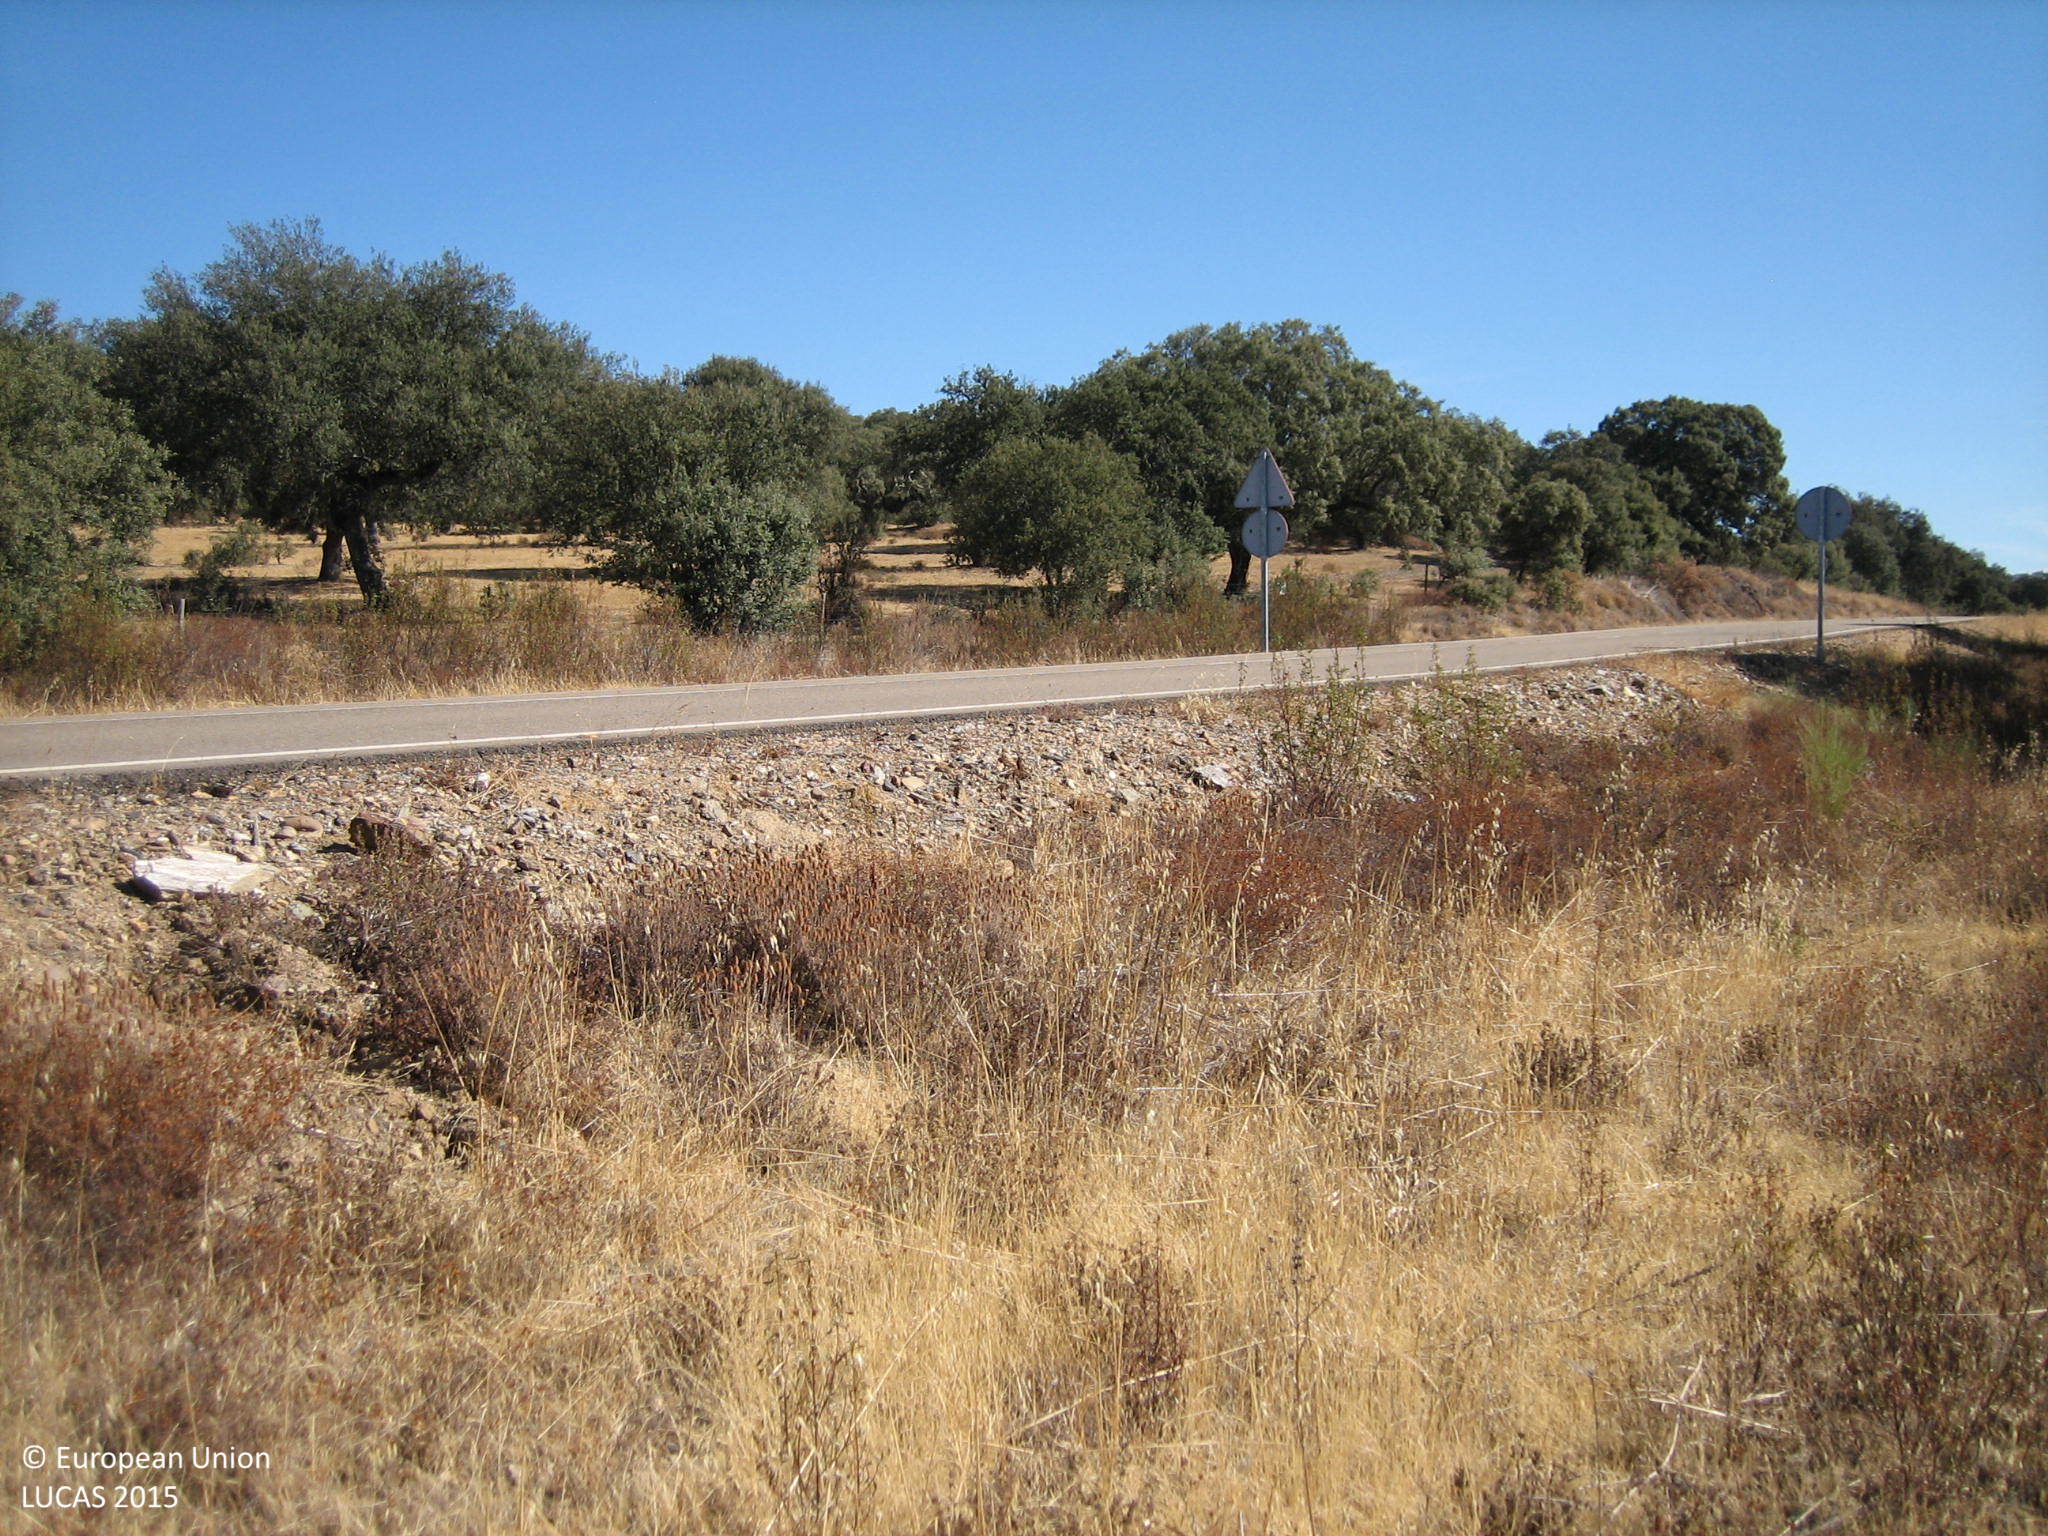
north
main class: Woodland
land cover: Broadleaved woodland
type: broadleaved evergreen forest
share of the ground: 10 - 25 %
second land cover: Shrubland without tree cover
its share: 10 - 25 %
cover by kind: herbaceous plants 40 %, broadleaved forest trees 20 %, shrubs 20 %, unconsolidated bare surface 20 %
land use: Forestry
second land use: Agriculture (excluding fallow land and kitchen gardens)
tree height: > 5 m
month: August
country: ES
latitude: 38.5115
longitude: -7.2132
